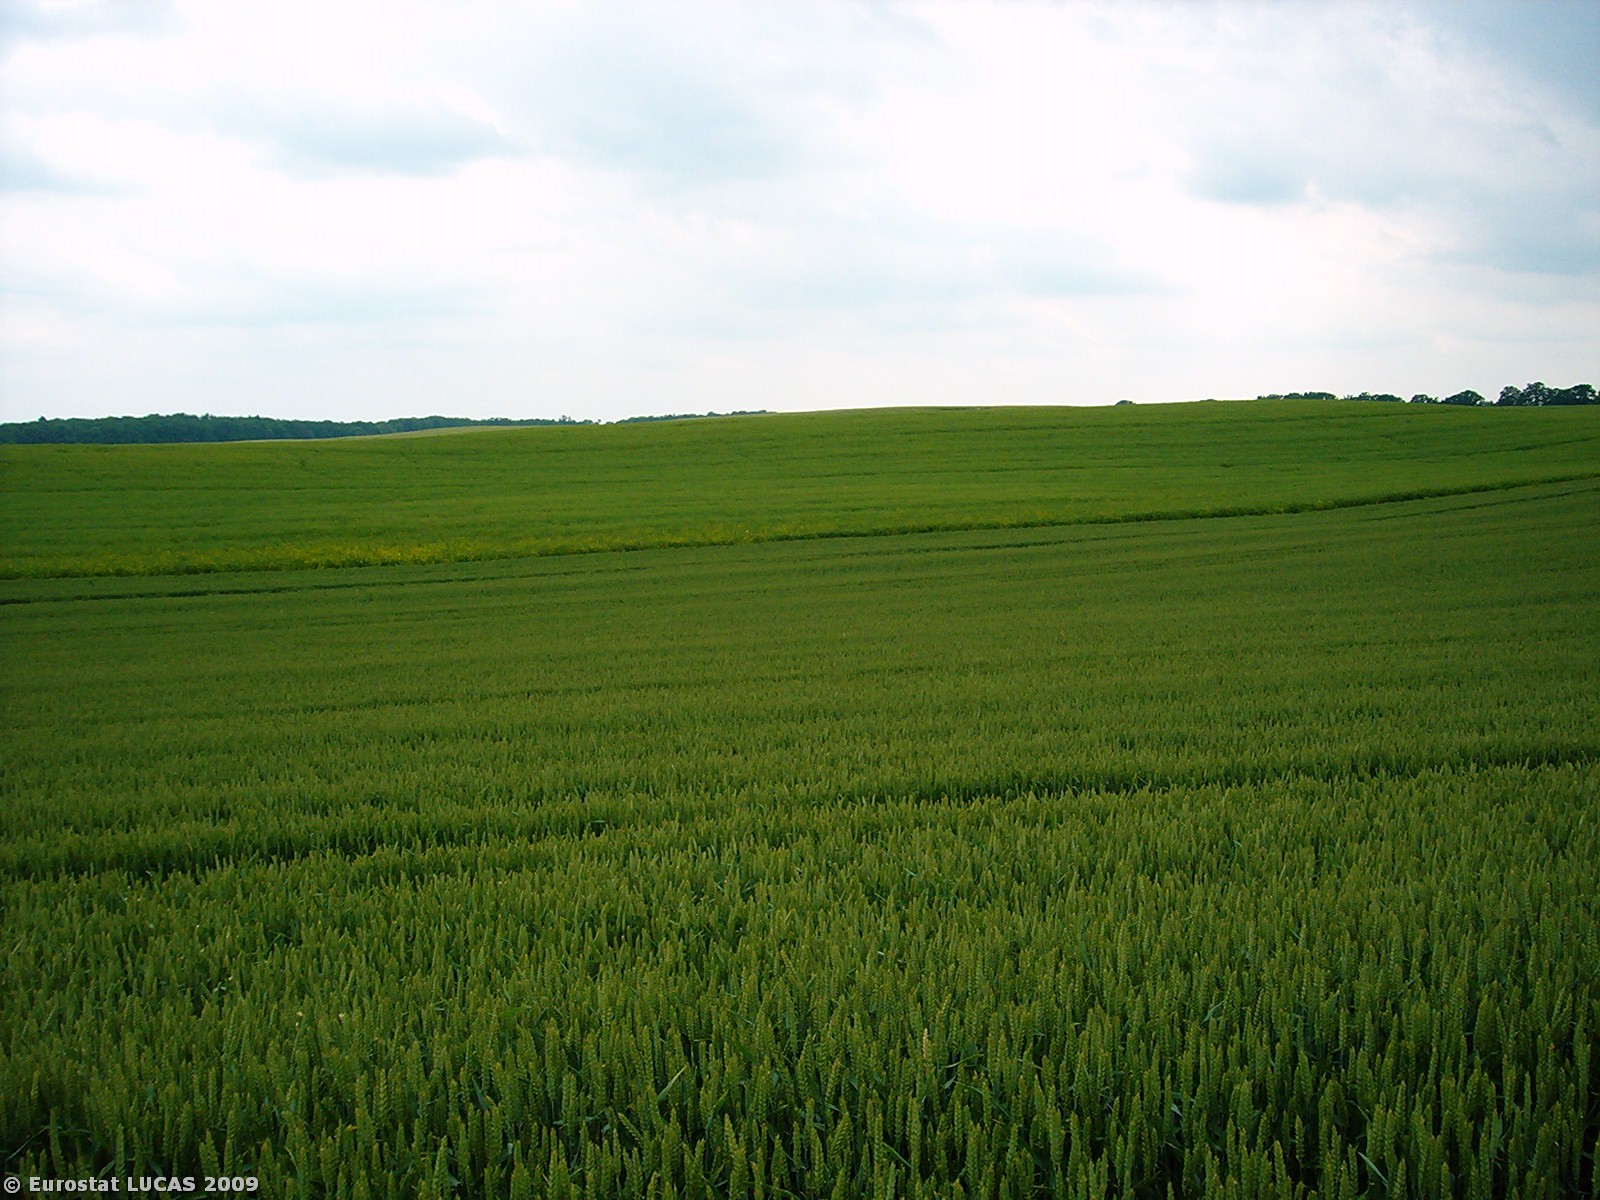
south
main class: Cropland
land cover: Common wheat
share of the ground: > 75 %
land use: Agriculture (excluding fallow land and kitchen gardens)
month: June
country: PL
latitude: 53.0273
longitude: 15.4456
